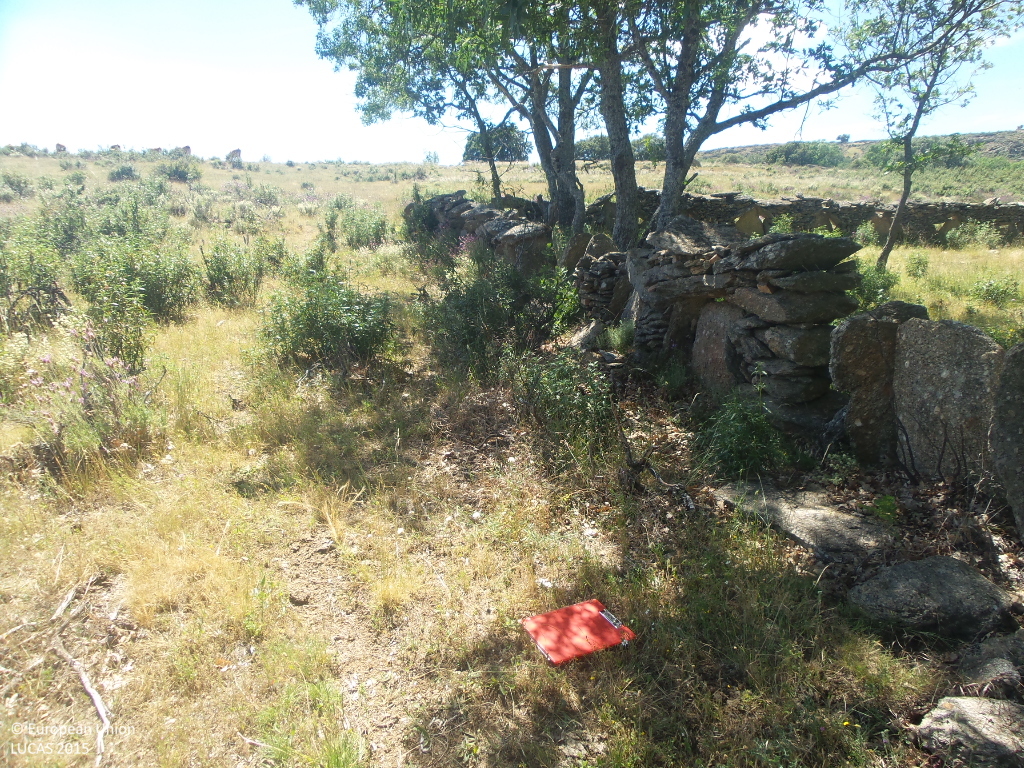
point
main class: Woodland
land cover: Broadleaved woodland
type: thermophilous deciduous forest
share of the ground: 50 - 75 %
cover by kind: broadleaved forest trees 35 %, shrubs 35 %, herbaceous plants 30 %
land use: Agriculture (excluding fallow land and kitchen gardens)
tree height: > 5 m
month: June
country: ES
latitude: 41.1076
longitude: -3.0771
